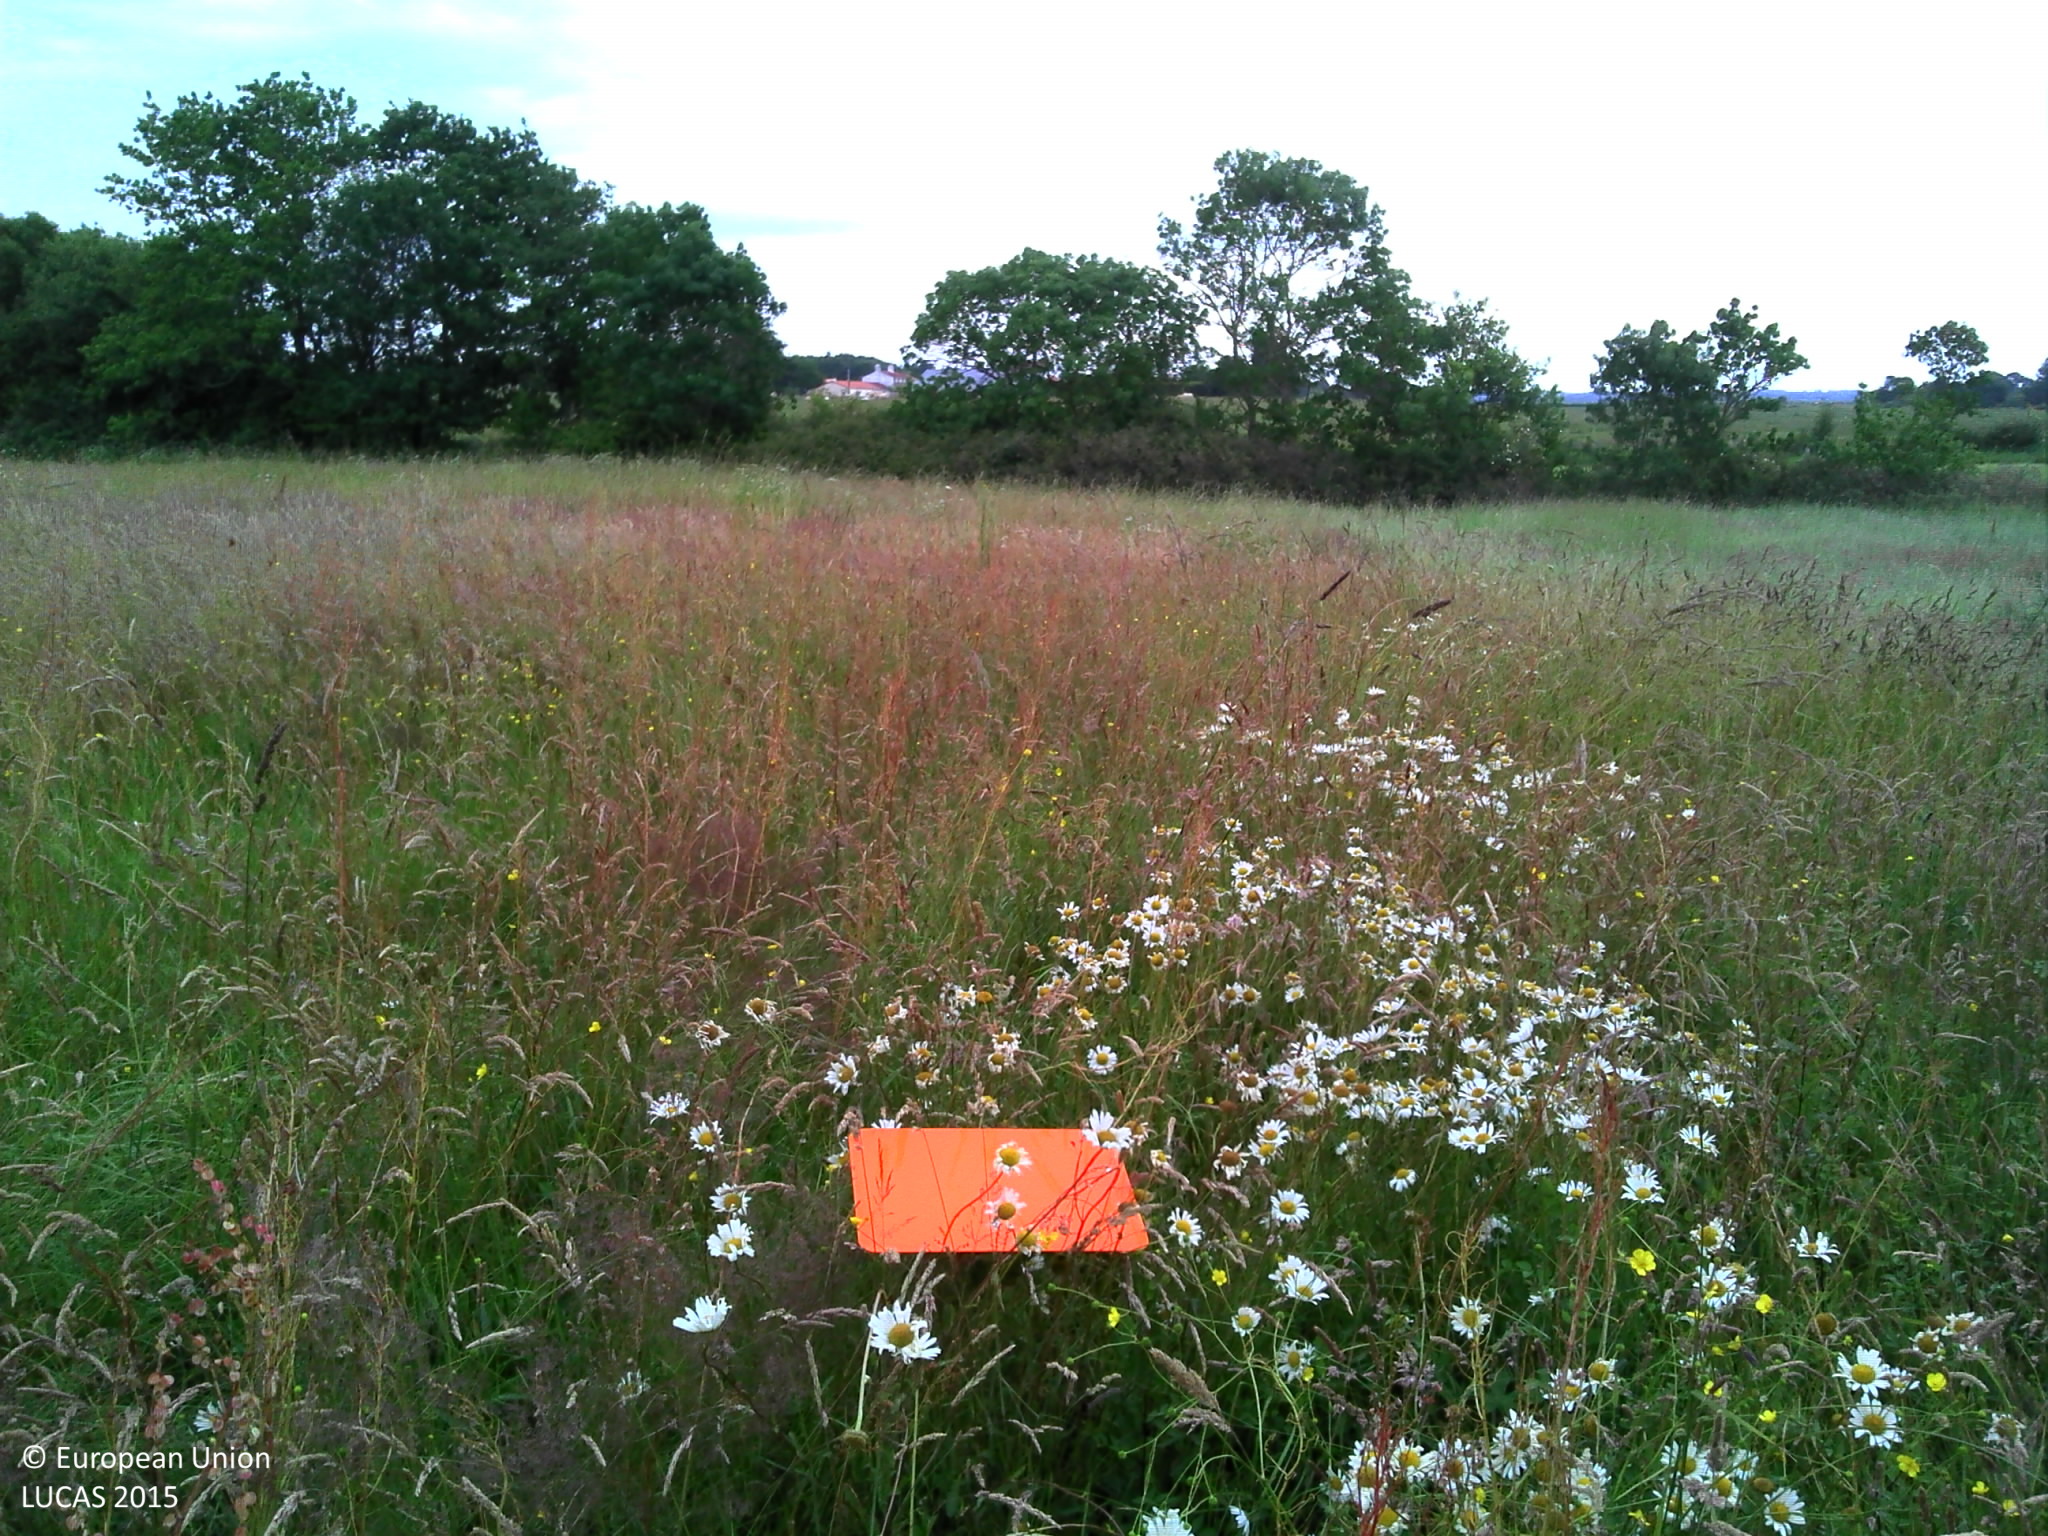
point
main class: Grassland
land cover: Grassland without tree/shrub cover
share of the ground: > 75 %
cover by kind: herbaceous plants 100 %
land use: Agriculture (excluding fallow land and kitchen gardens)
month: June
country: FR
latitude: 47.1253
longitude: -2.0305
